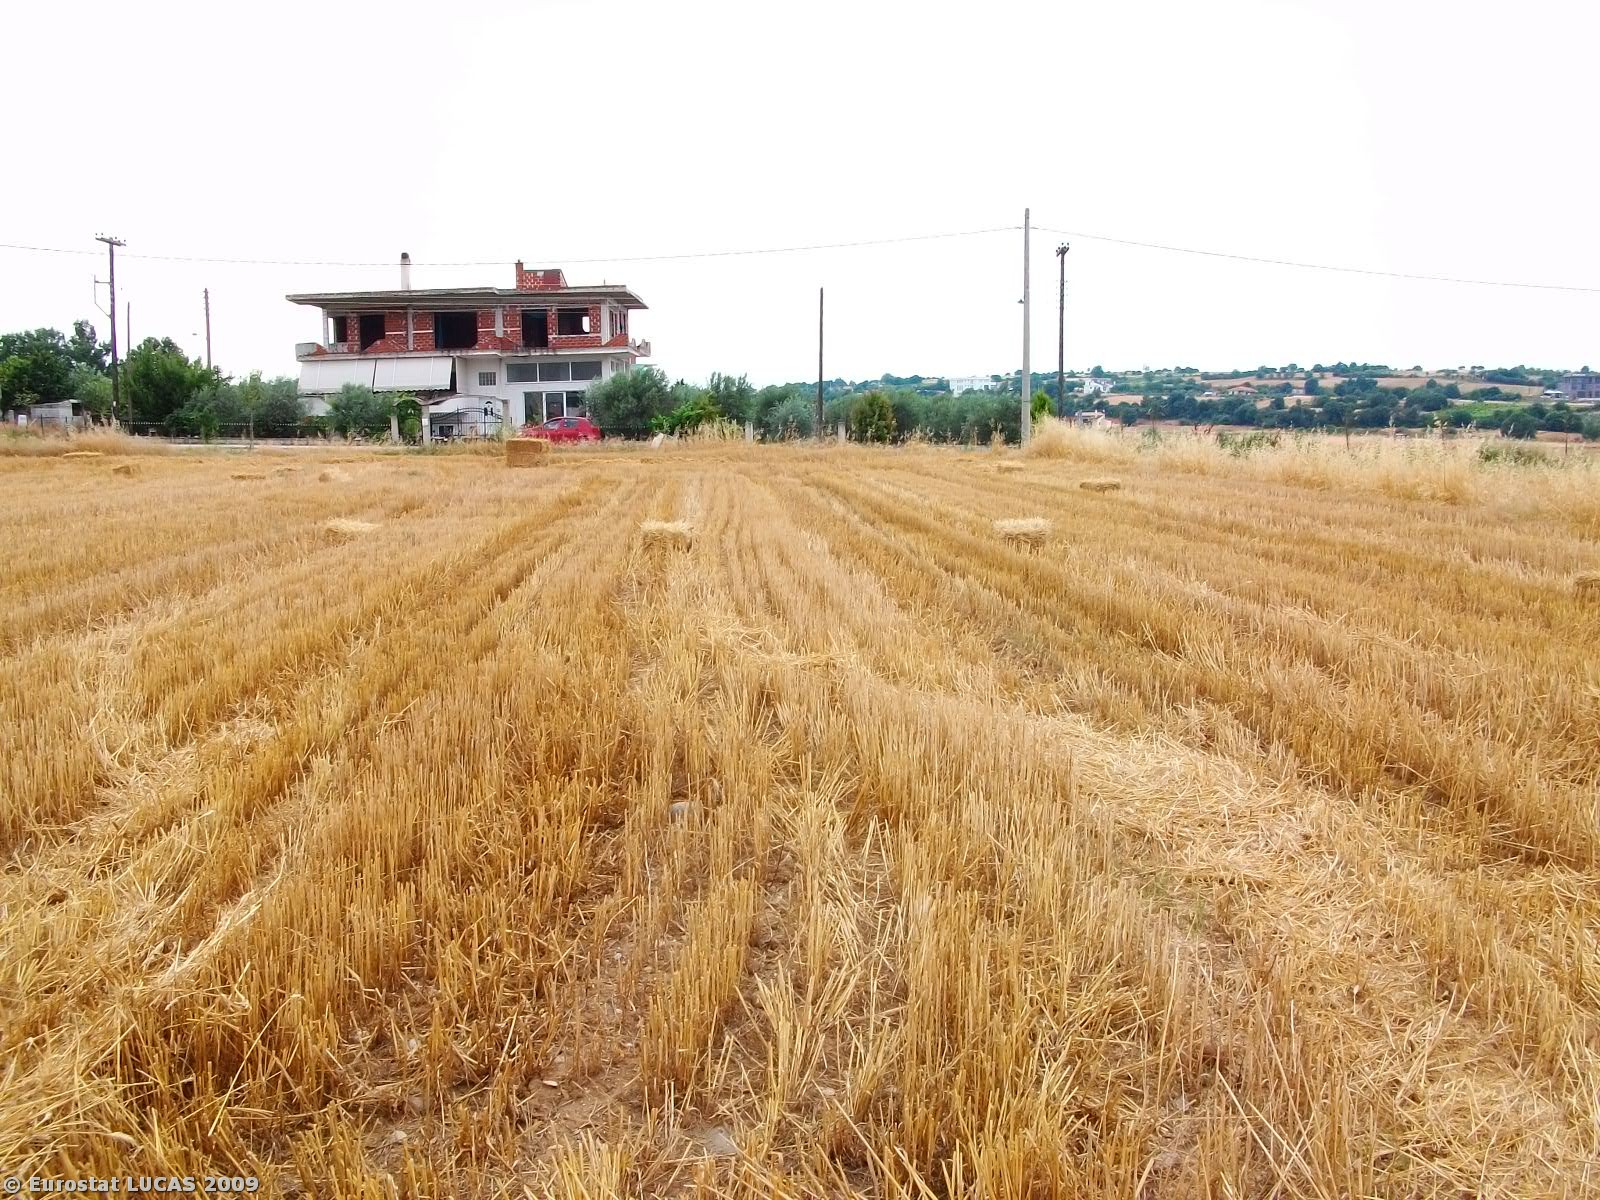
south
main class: Cropland
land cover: Durum wheat
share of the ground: > 75 %
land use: Agriculture (excluding fallow land and kitchen gardens)
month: June
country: GR
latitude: 41.0878
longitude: 23.6277
